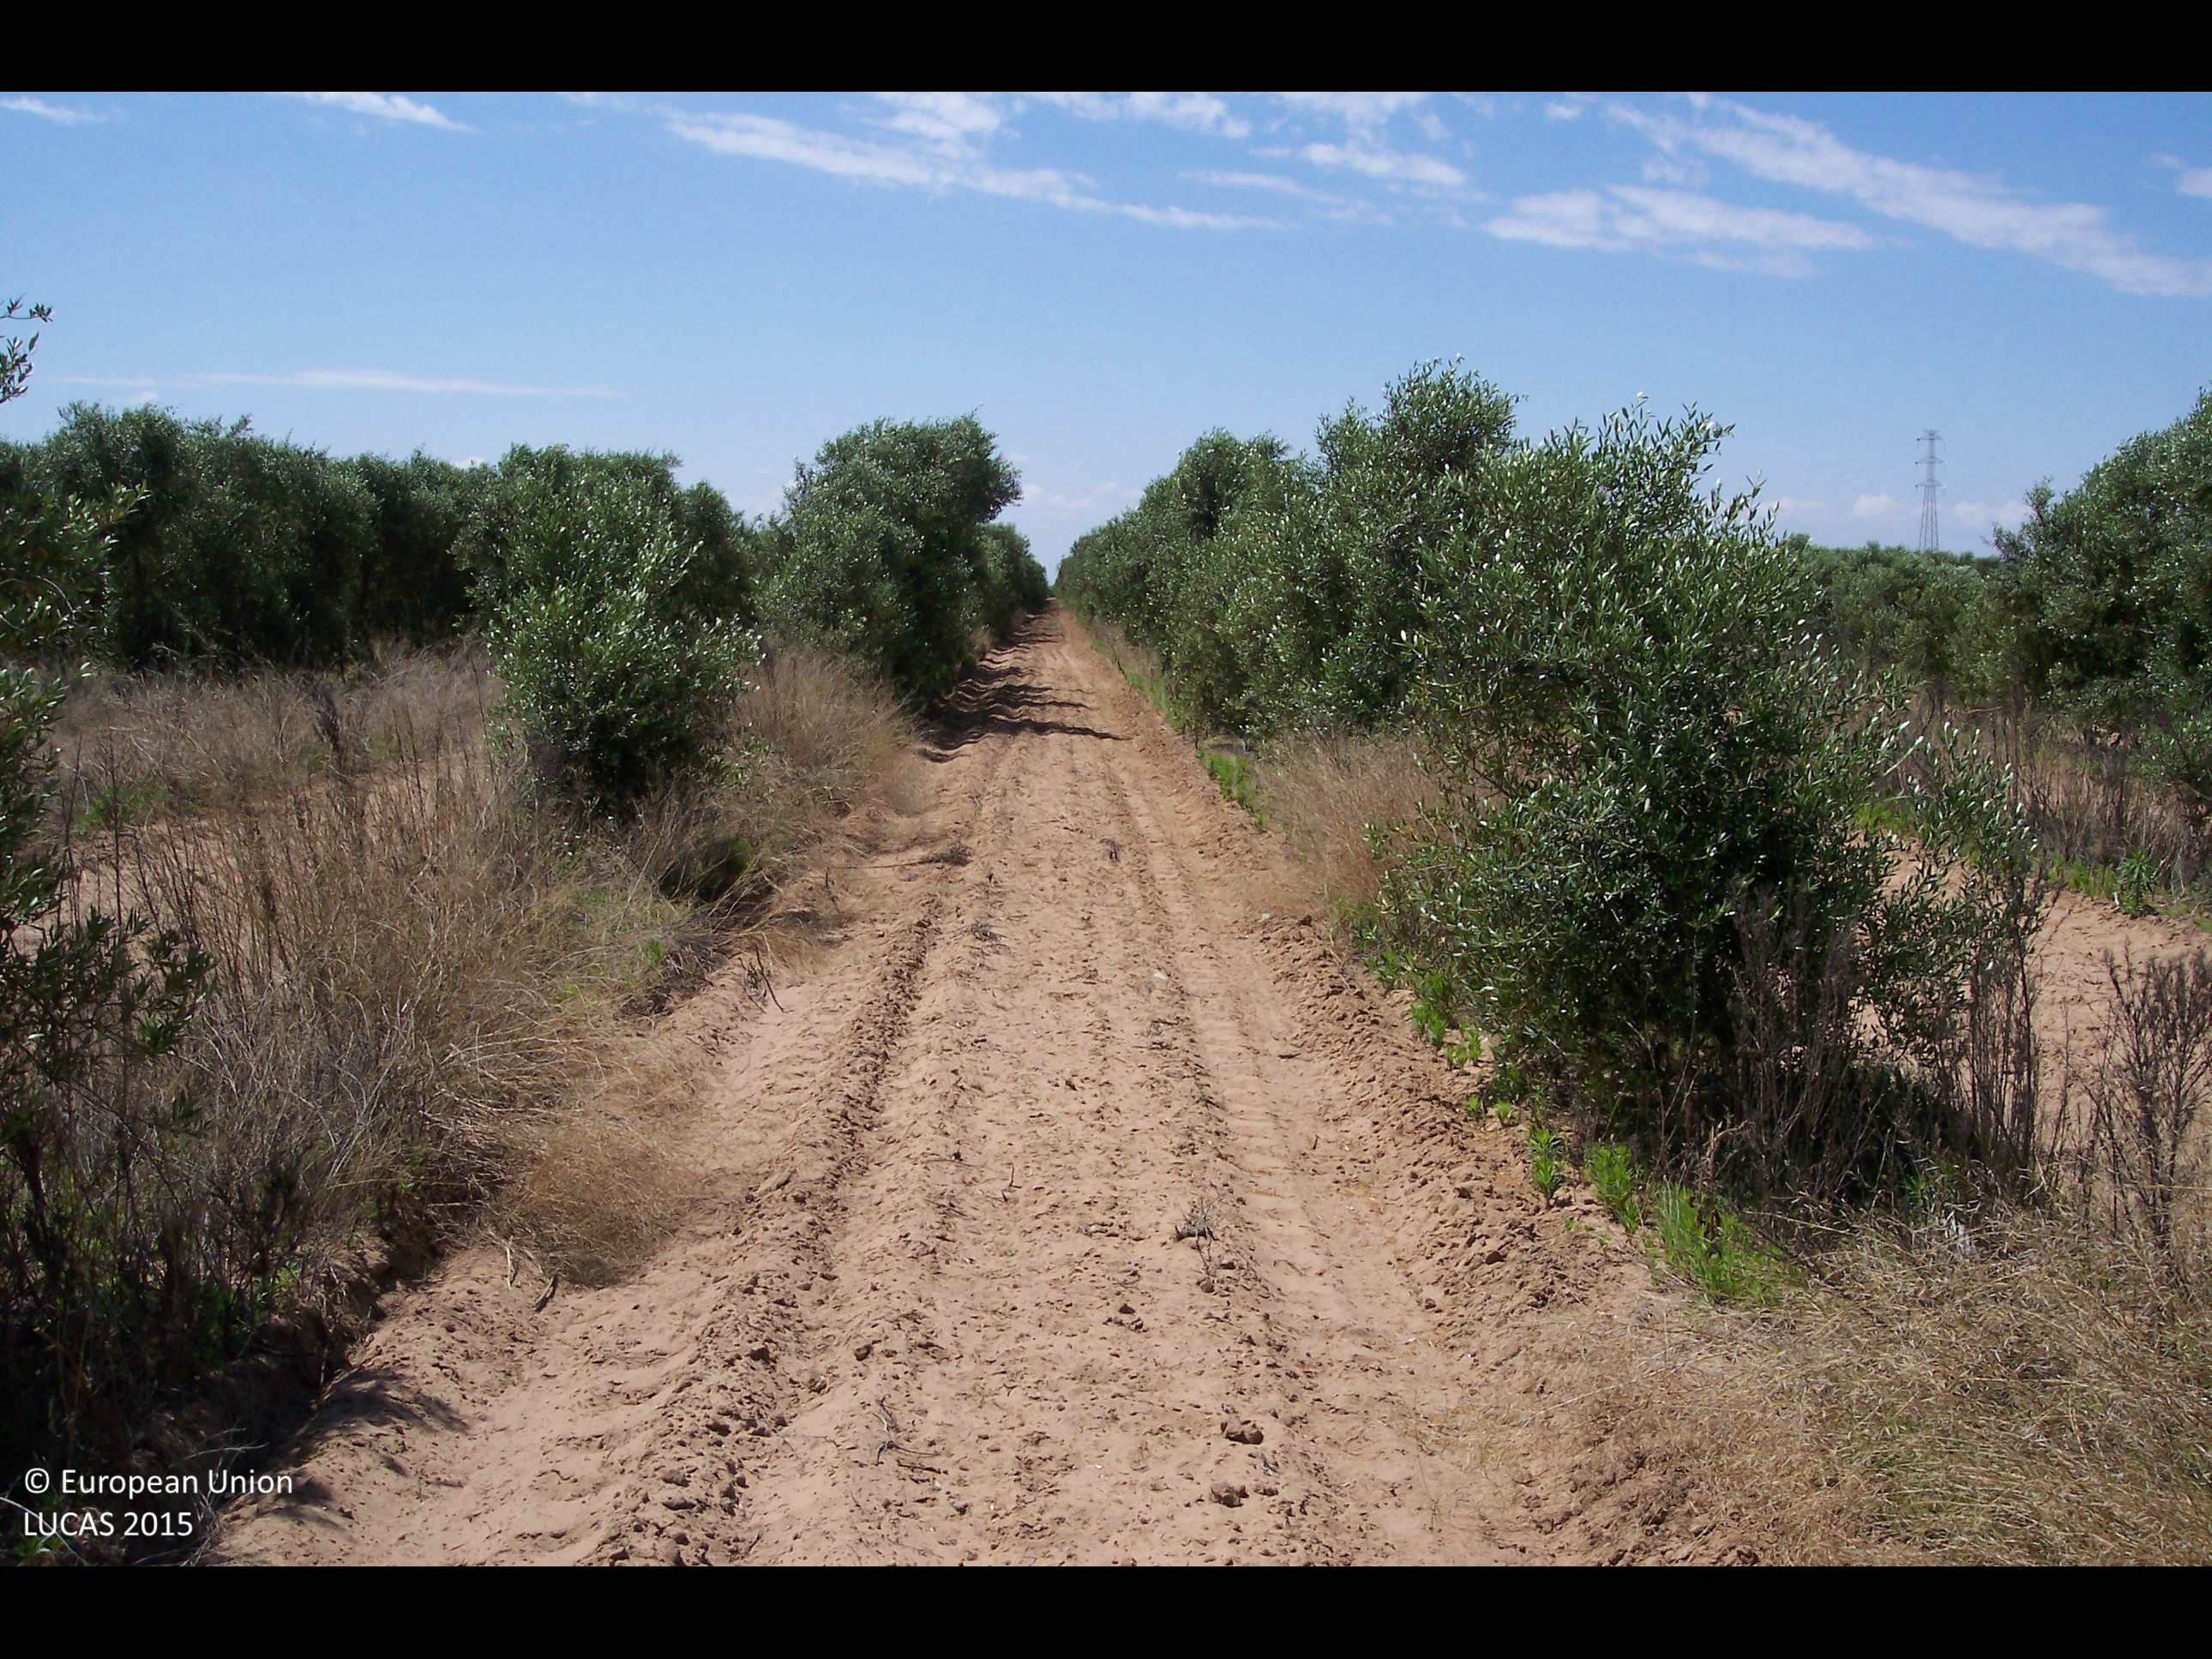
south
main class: Cropland
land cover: Olive groves
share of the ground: 25 - 50 %
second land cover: Spontaneously vegetated surfaces
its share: 10 - 25 %
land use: Agriculture (excluding fallow land and kitchen gardens)
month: May
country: ES
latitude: 37.2199
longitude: -5.8519
